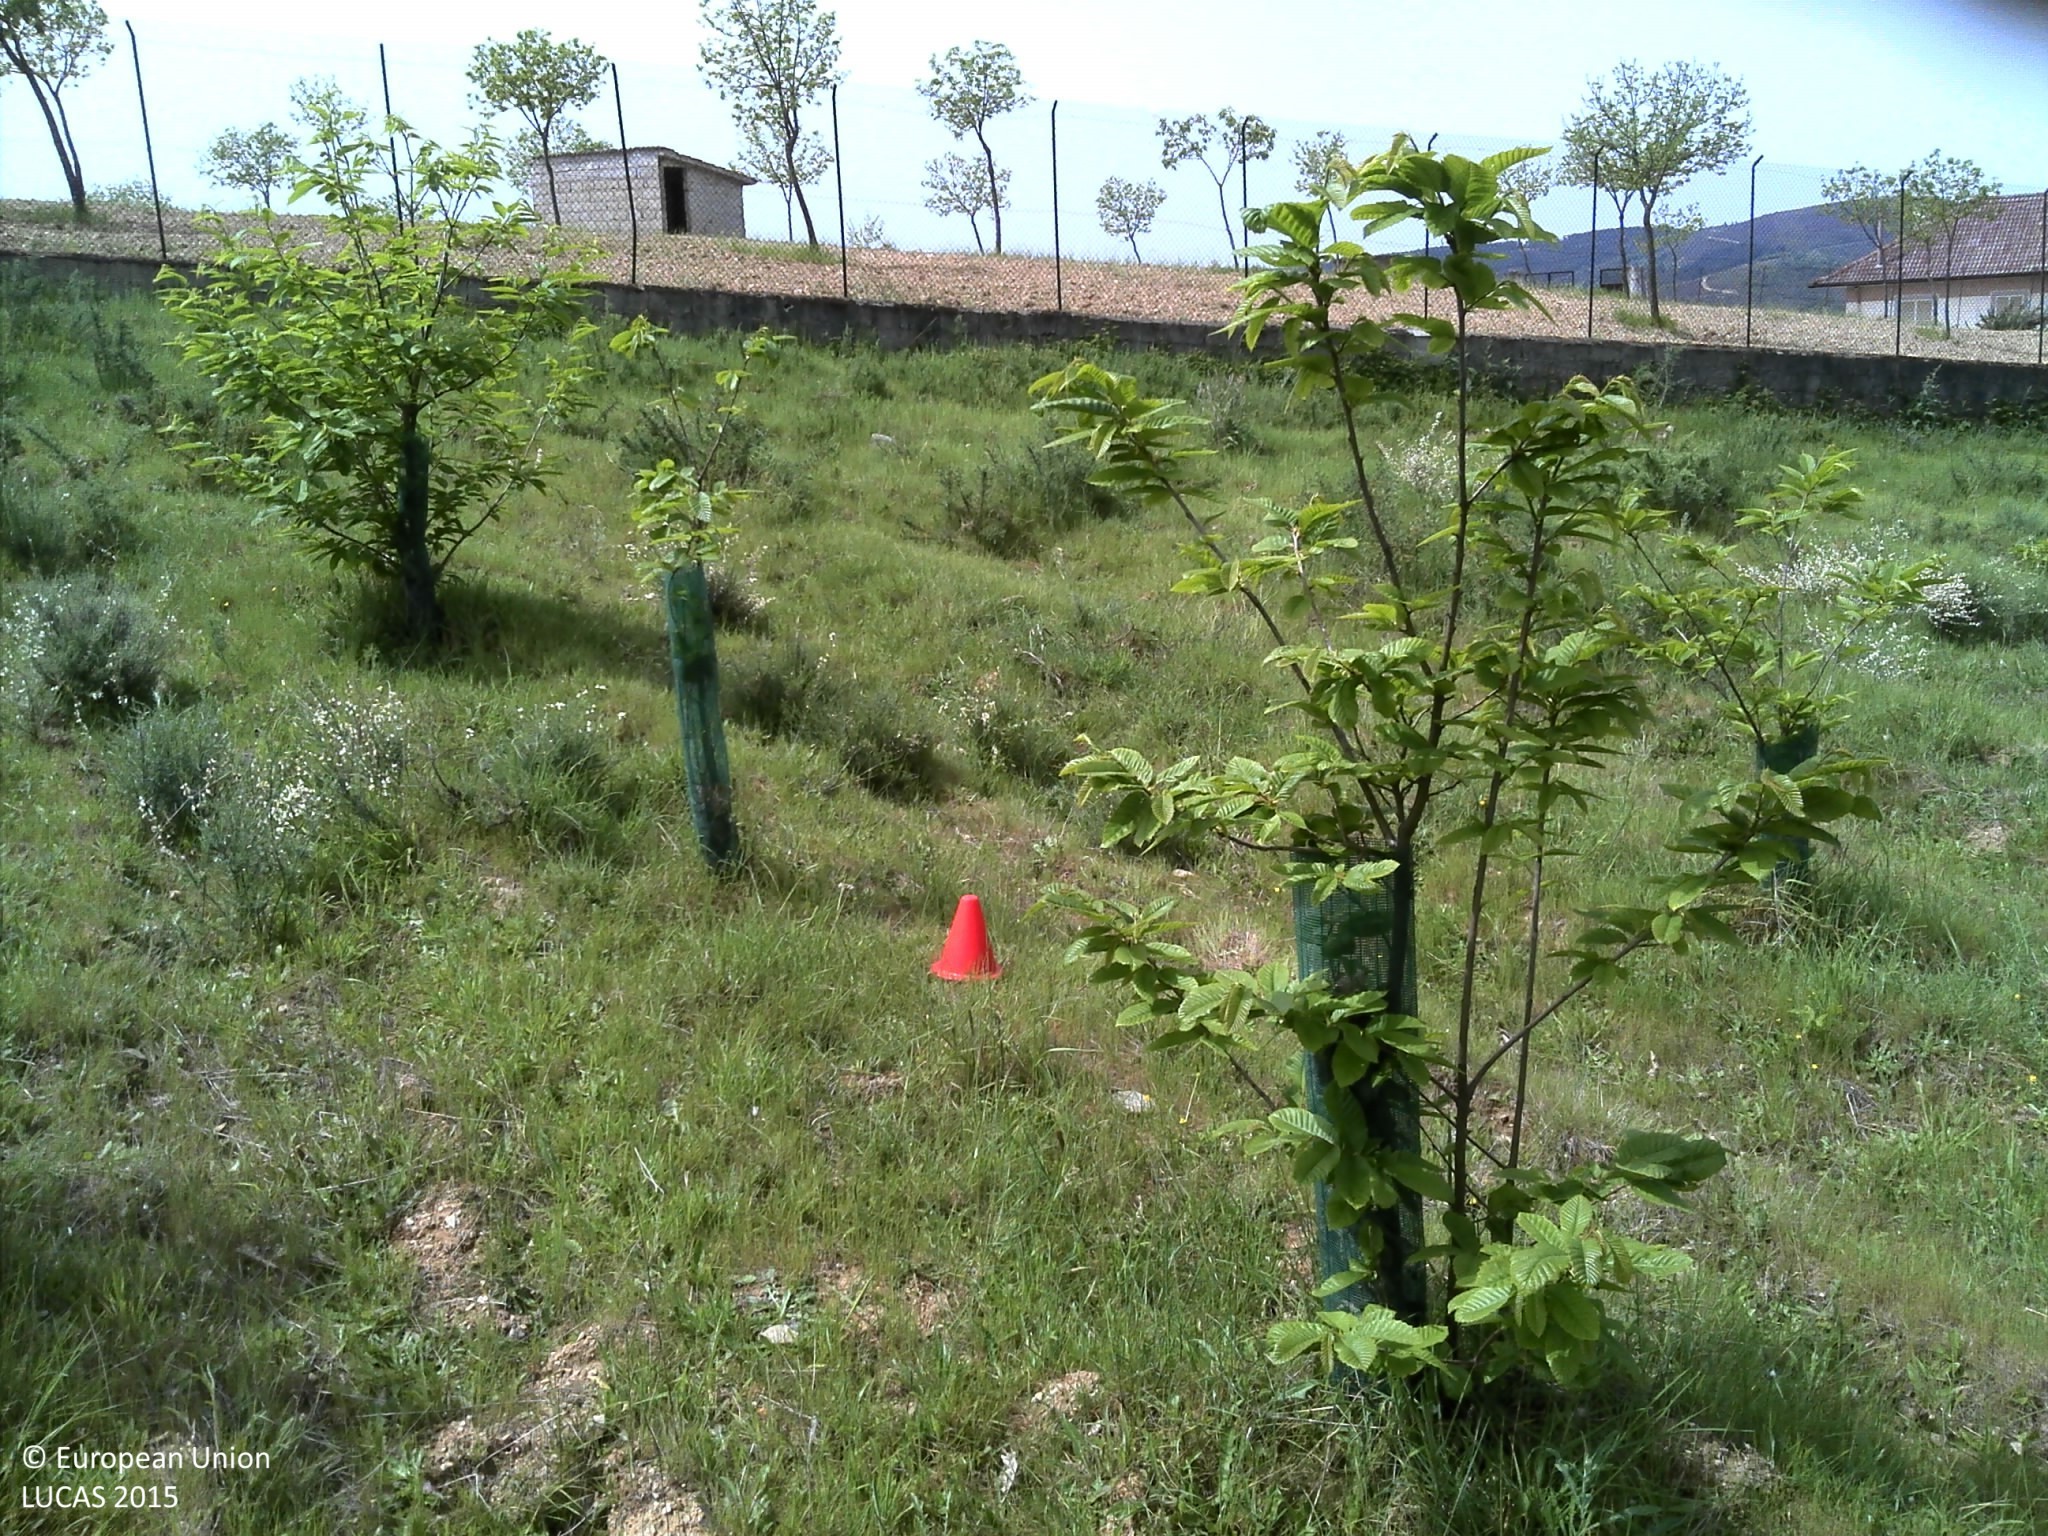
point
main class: Cropland
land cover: Nuts trees
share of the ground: 10 - 25 %
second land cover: Grassland without tree/shrub cover
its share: 25 - 50 %
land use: Agriculture (excluding fallow land and kitchen gardens)
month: May
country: PT
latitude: 41.9310
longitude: -7.1656
